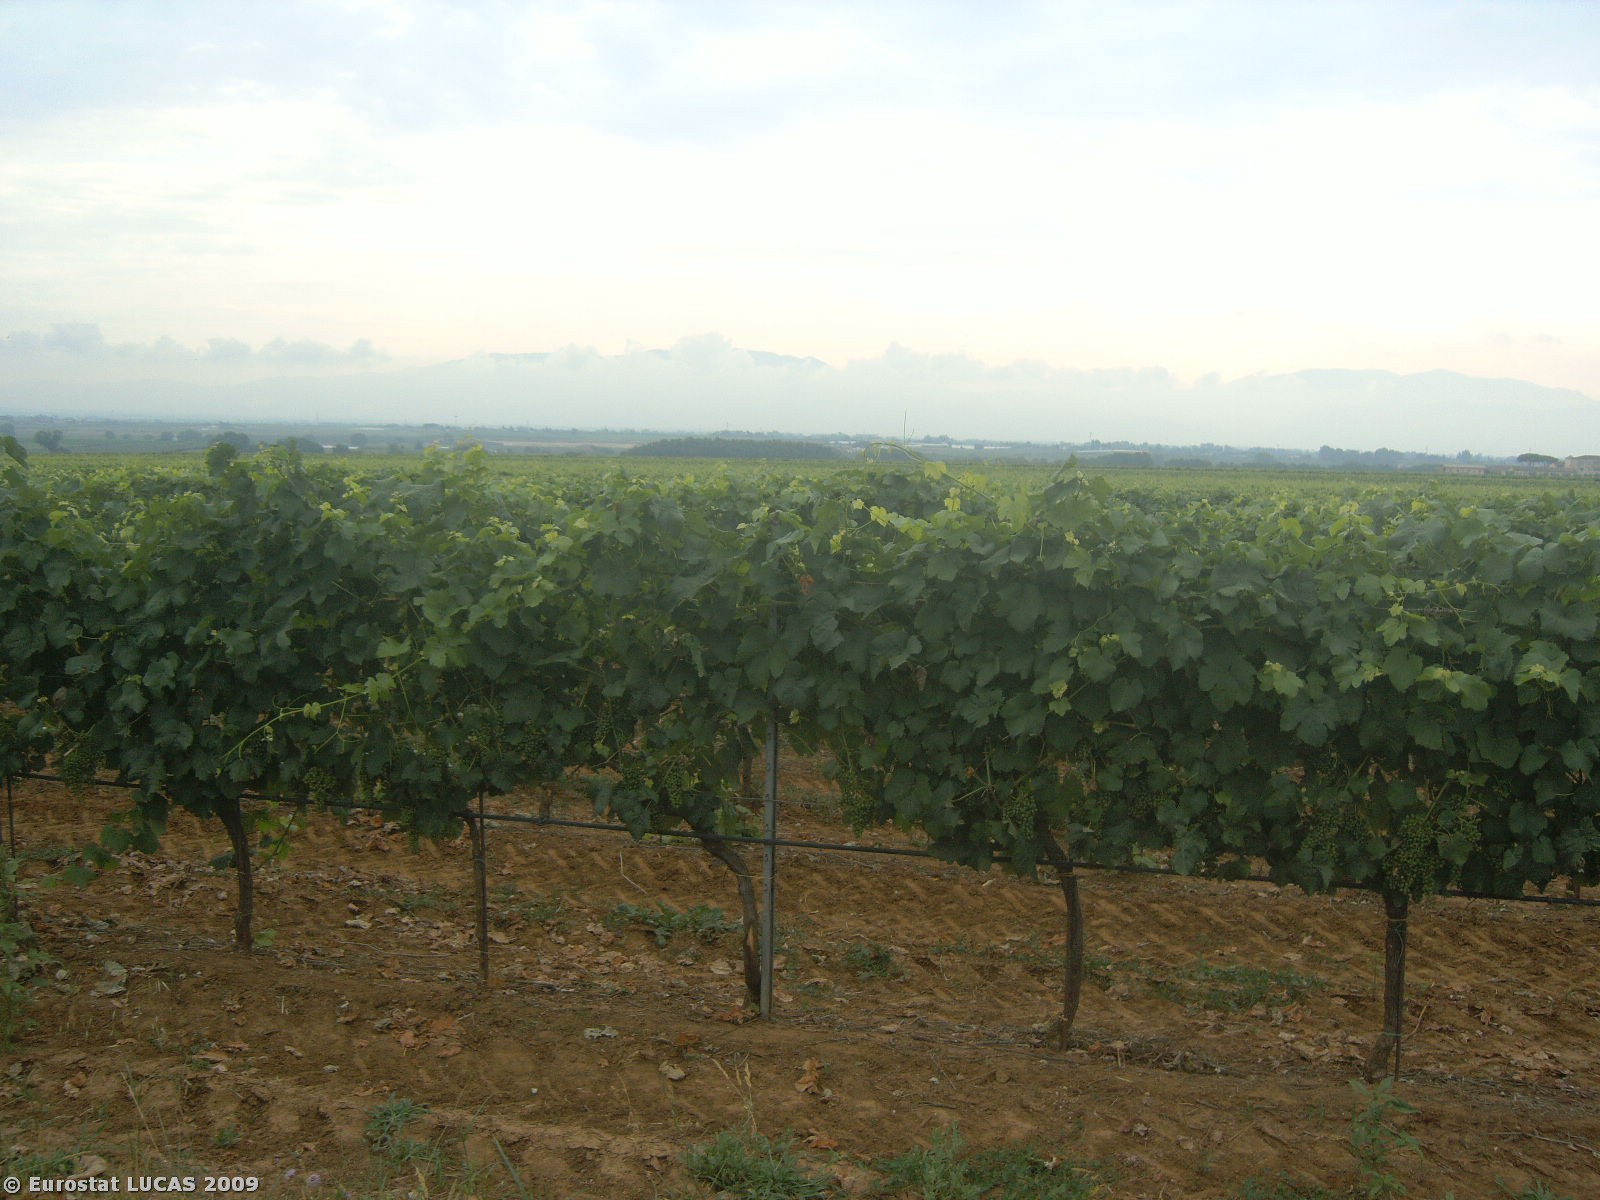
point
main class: Cropland
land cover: Vineyards
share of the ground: 50 - 75 %
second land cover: Bare land
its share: 10 - 25 %
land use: Agriculture (excluding fallow land and kitchen gardens)
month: June
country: IT
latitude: 41.5143
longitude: 12.7330
